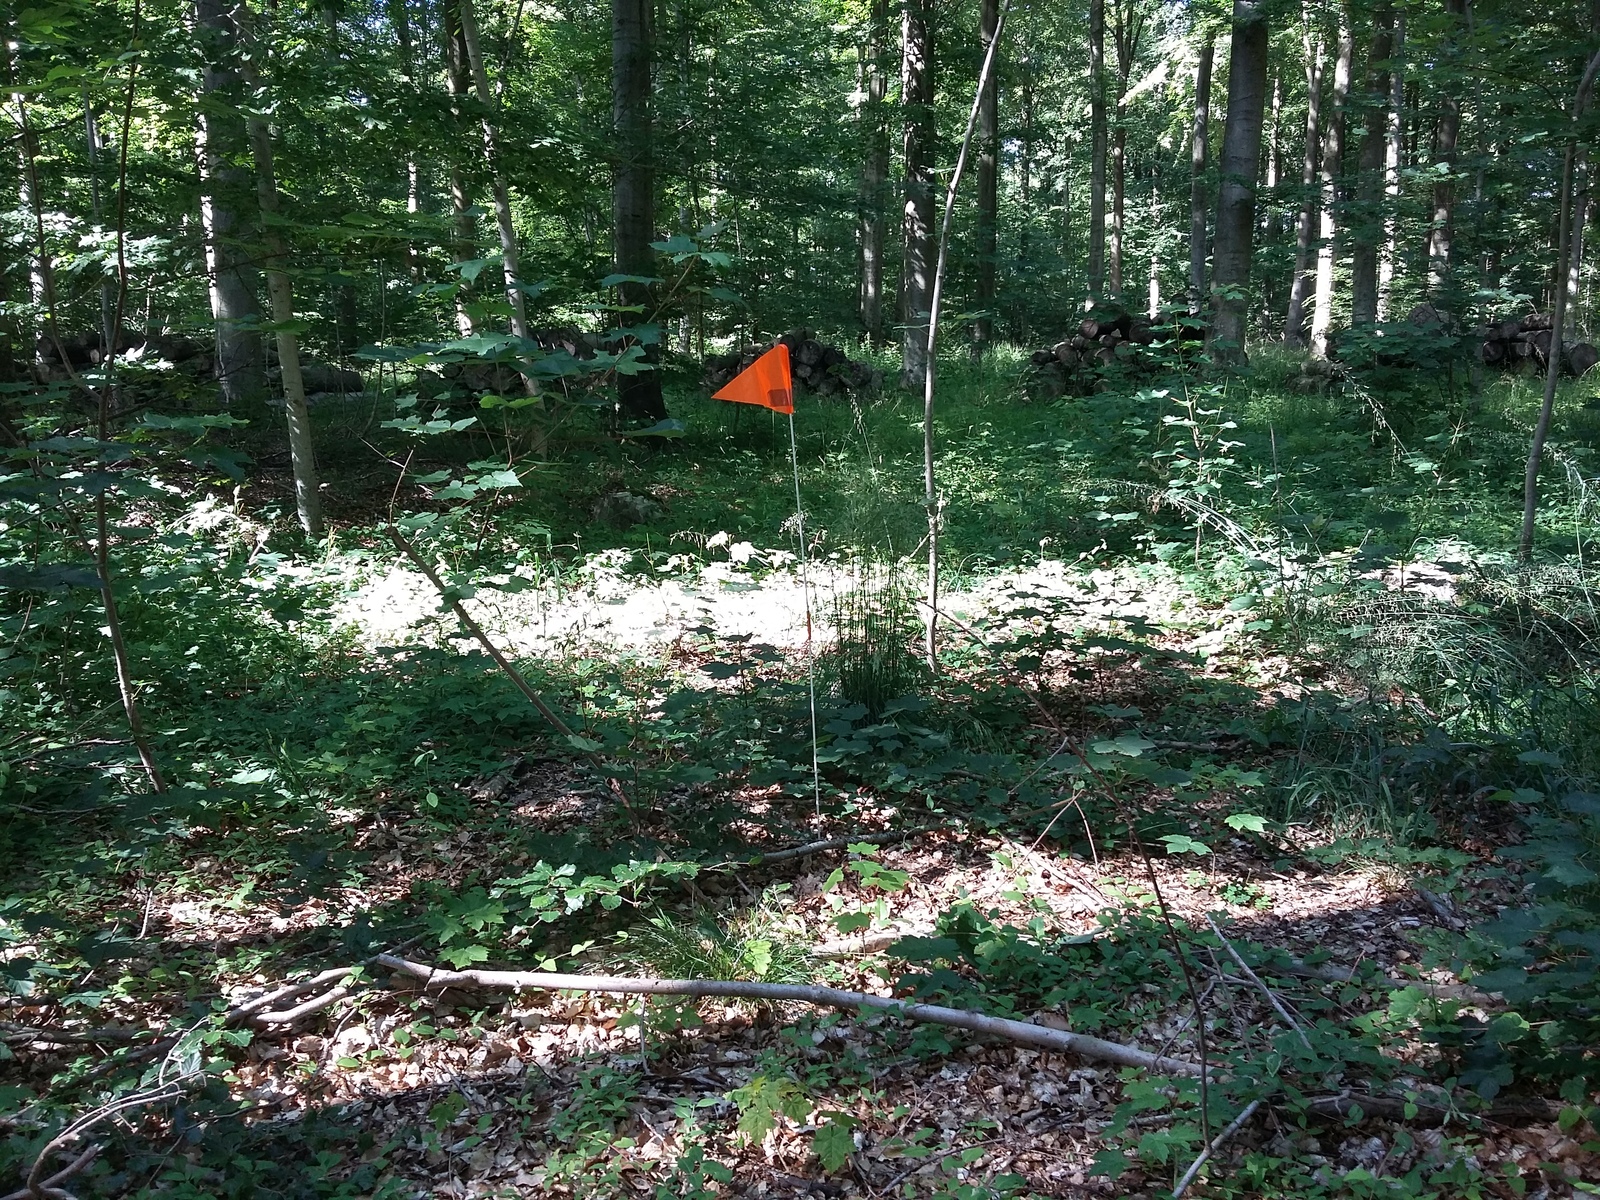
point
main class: Woodland
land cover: Broadleaved woodland
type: beech forest
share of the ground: > 75 %
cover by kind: broadleaved forest trees 80 %, herbaceous plants 20 %
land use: Forestry
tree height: > 5 m
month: June
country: DK
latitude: 54.8255
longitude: 11.8822
